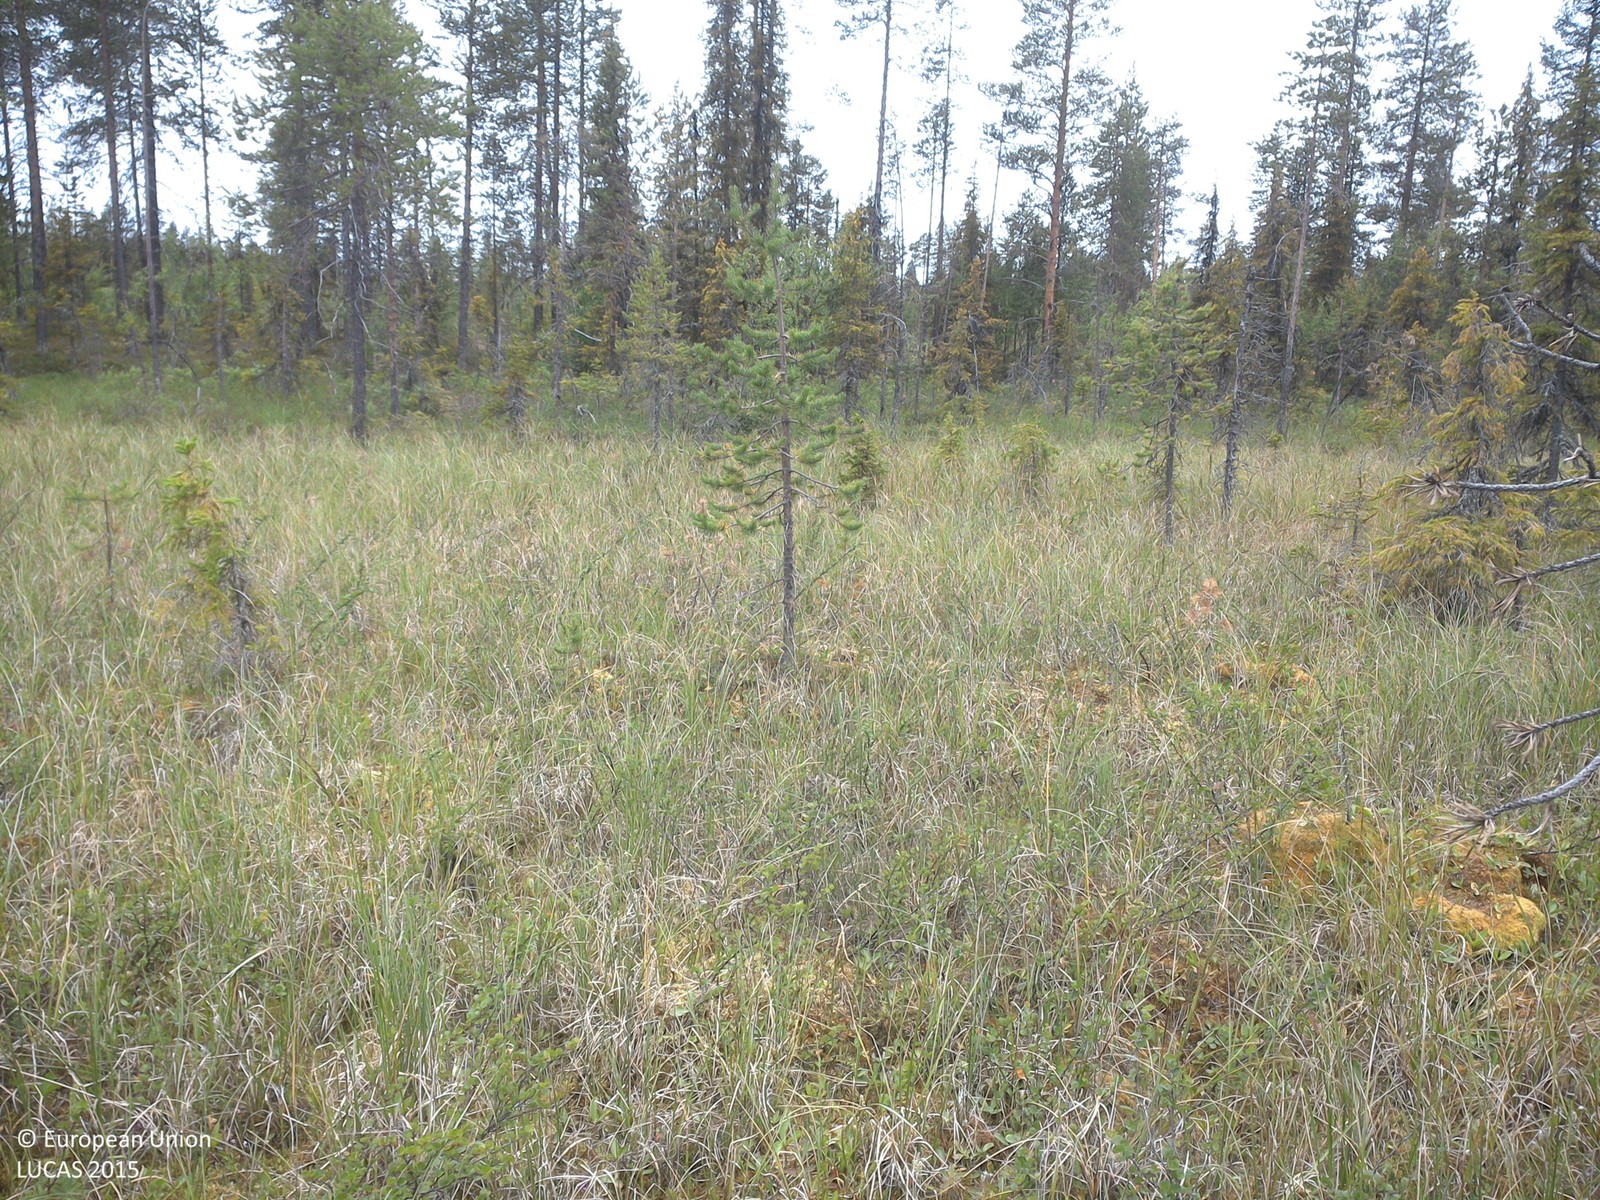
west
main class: Woodland
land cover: Pine dominated coniferous woodland
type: boreal forest
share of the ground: 10 - 25 %
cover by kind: herbaceous plants 55 %, lichens and mosses 25 %, coniferous forest trees 10 %, shrubs 10 %
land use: Semi-natural and natural areas not in use
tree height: < 5 m
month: July
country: SE
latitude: 67.5154
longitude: 22.3042
